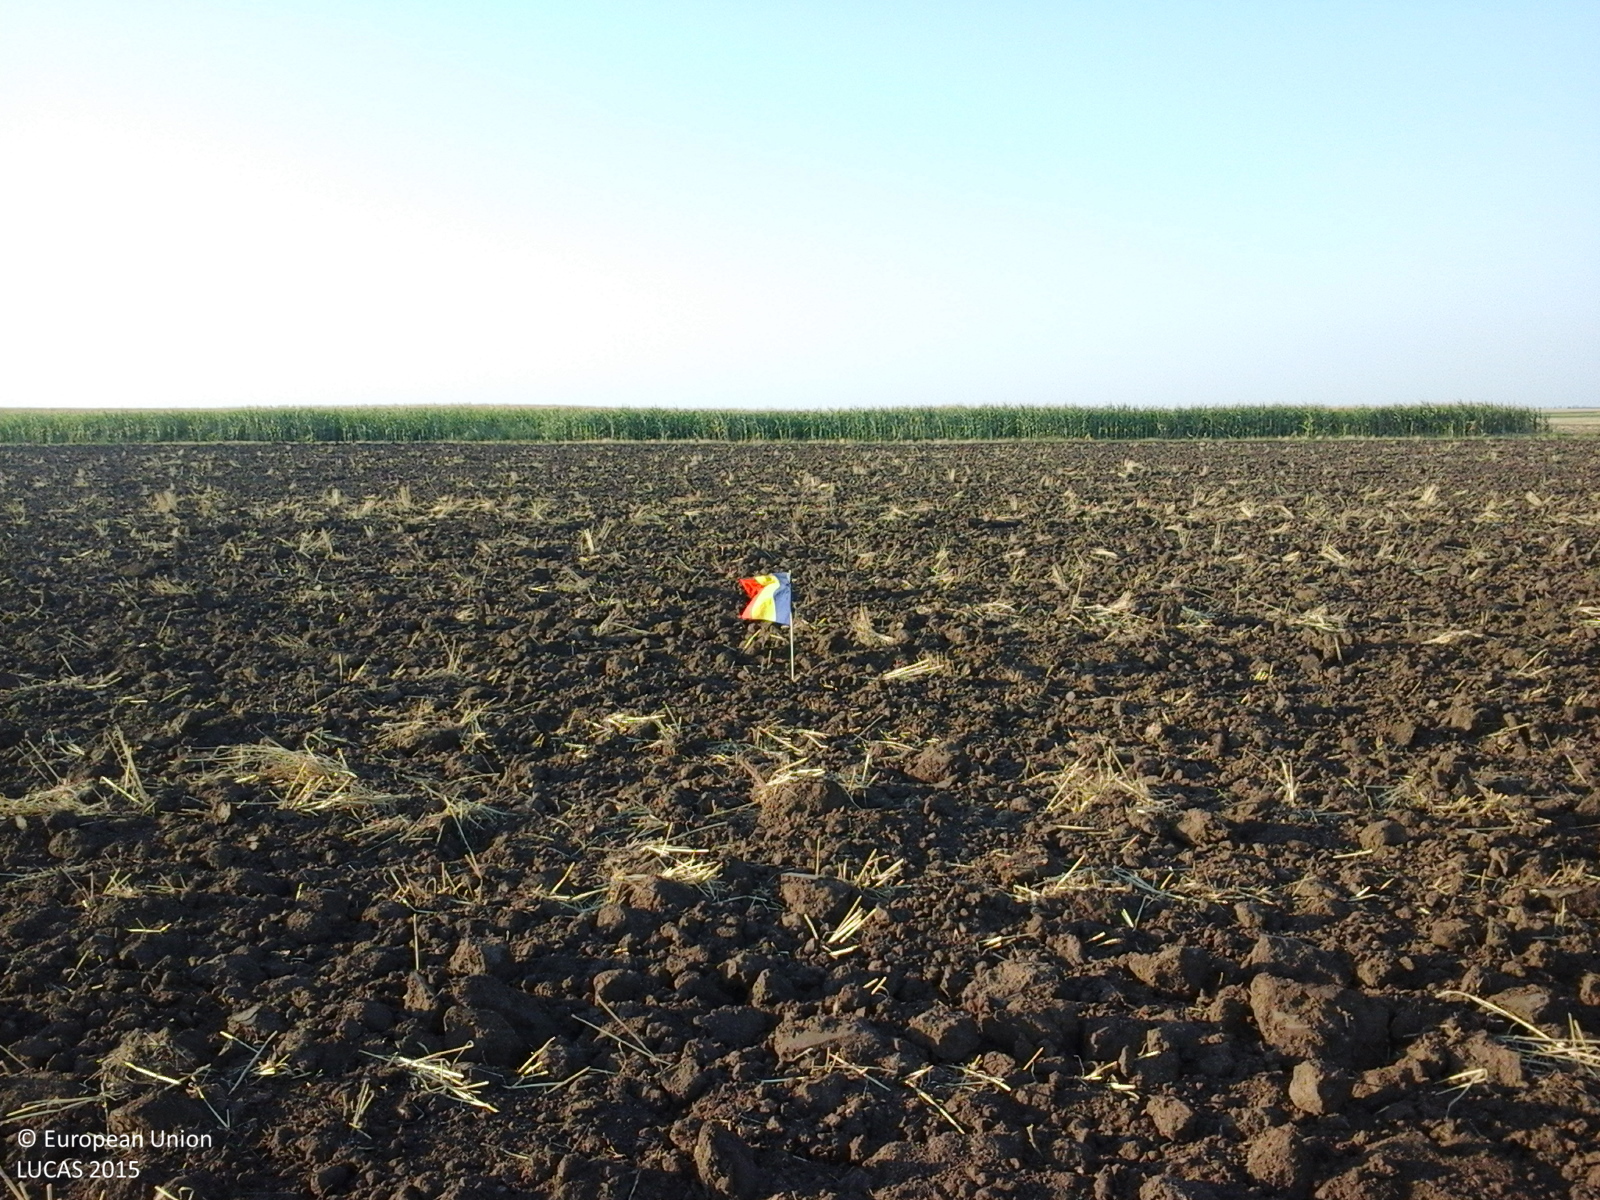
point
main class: Cropland
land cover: Common wheat
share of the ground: < 10 %
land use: Agriculture (excluding fallow land and kitchen gardens)
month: July
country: RO
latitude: 44.7987
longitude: 27.1910
